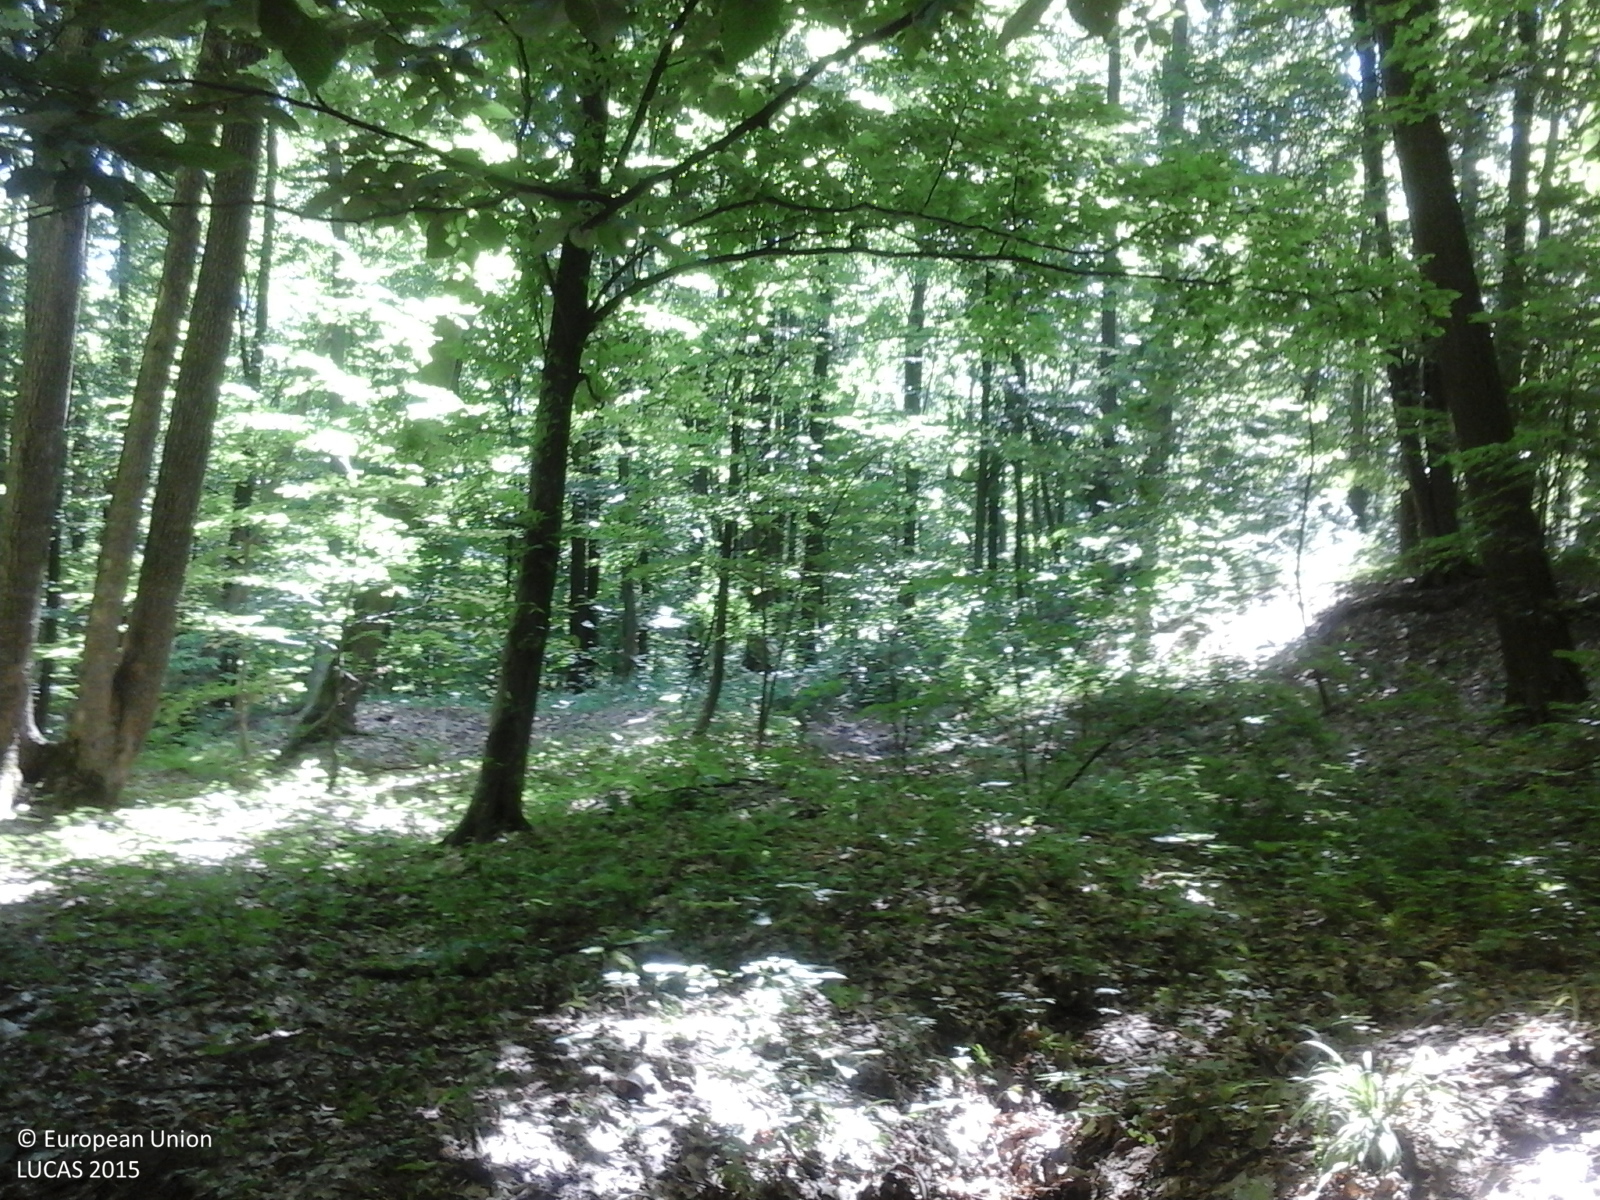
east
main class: Woodland
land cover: Broadleaved woodland
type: thermophilous deciduous forest
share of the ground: > 75 %
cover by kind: broadleaved forest trees 100 %
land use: Forestry
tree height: > 5 m
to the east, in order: Broadleaved woodland
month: June
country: RO
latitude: 47.0930
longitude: 27.1111
